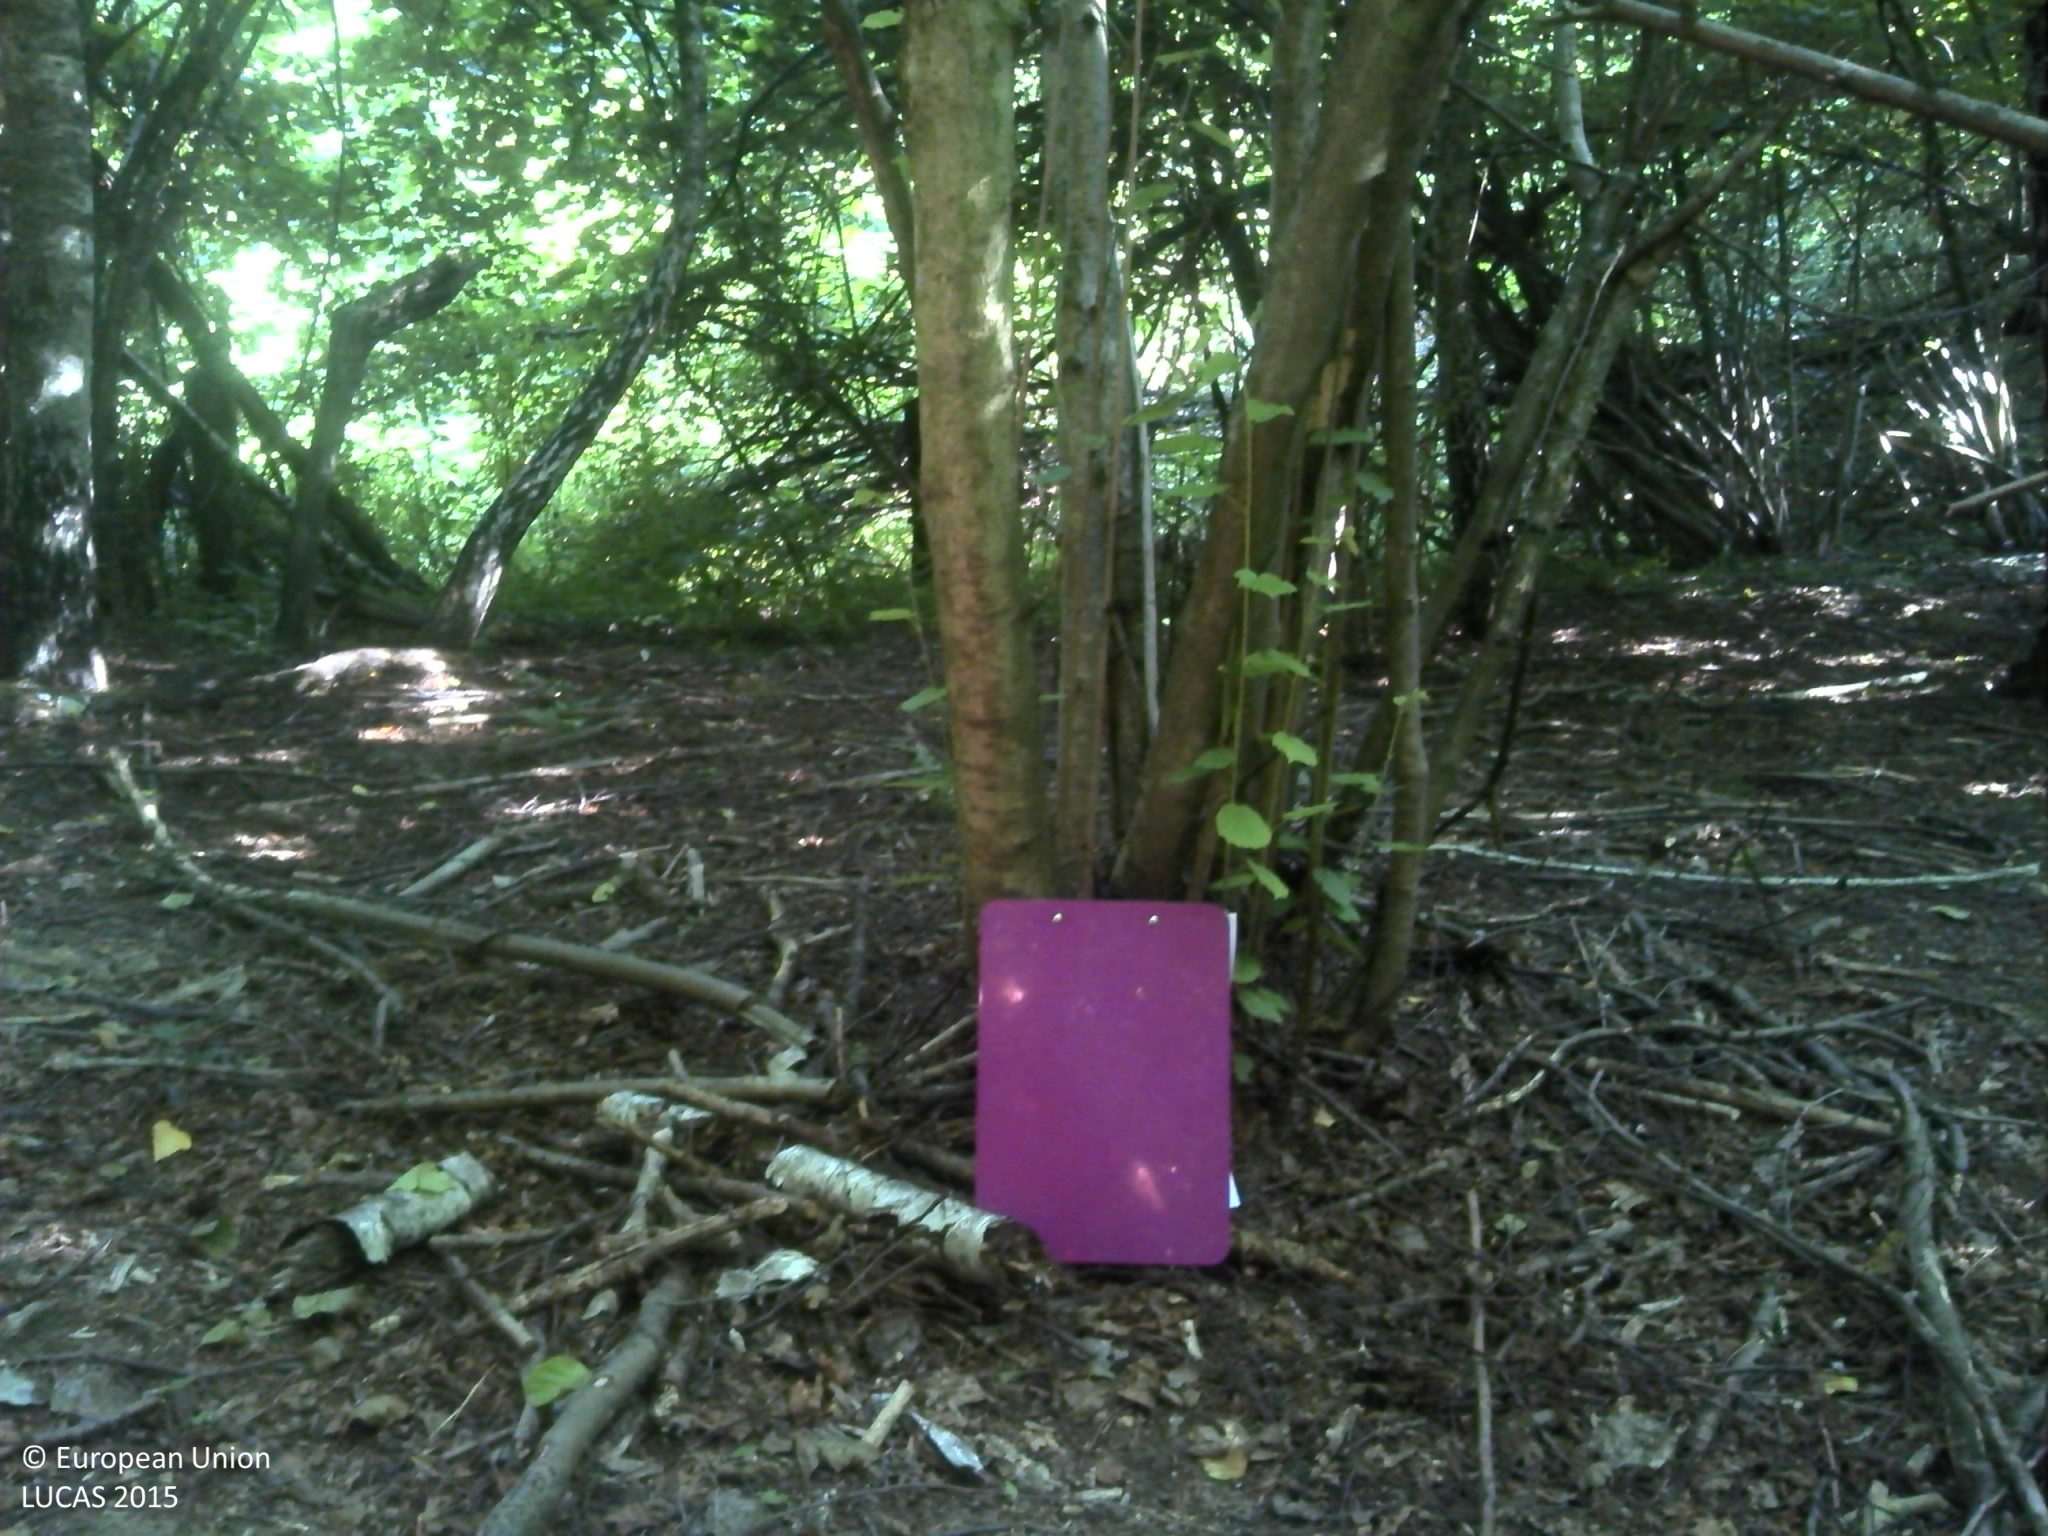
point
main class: Woodland
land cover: Broadleaved woodland
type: acidophilous oak and oak-birch forest
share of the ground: > 75 %
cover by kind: broadleaved forest trees 90 %, shrubs 5 %, herbaceous plants 5 %
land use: Forestry
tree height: > 5 m
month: June
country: HR
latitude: 45.5900
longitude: 17.6291
